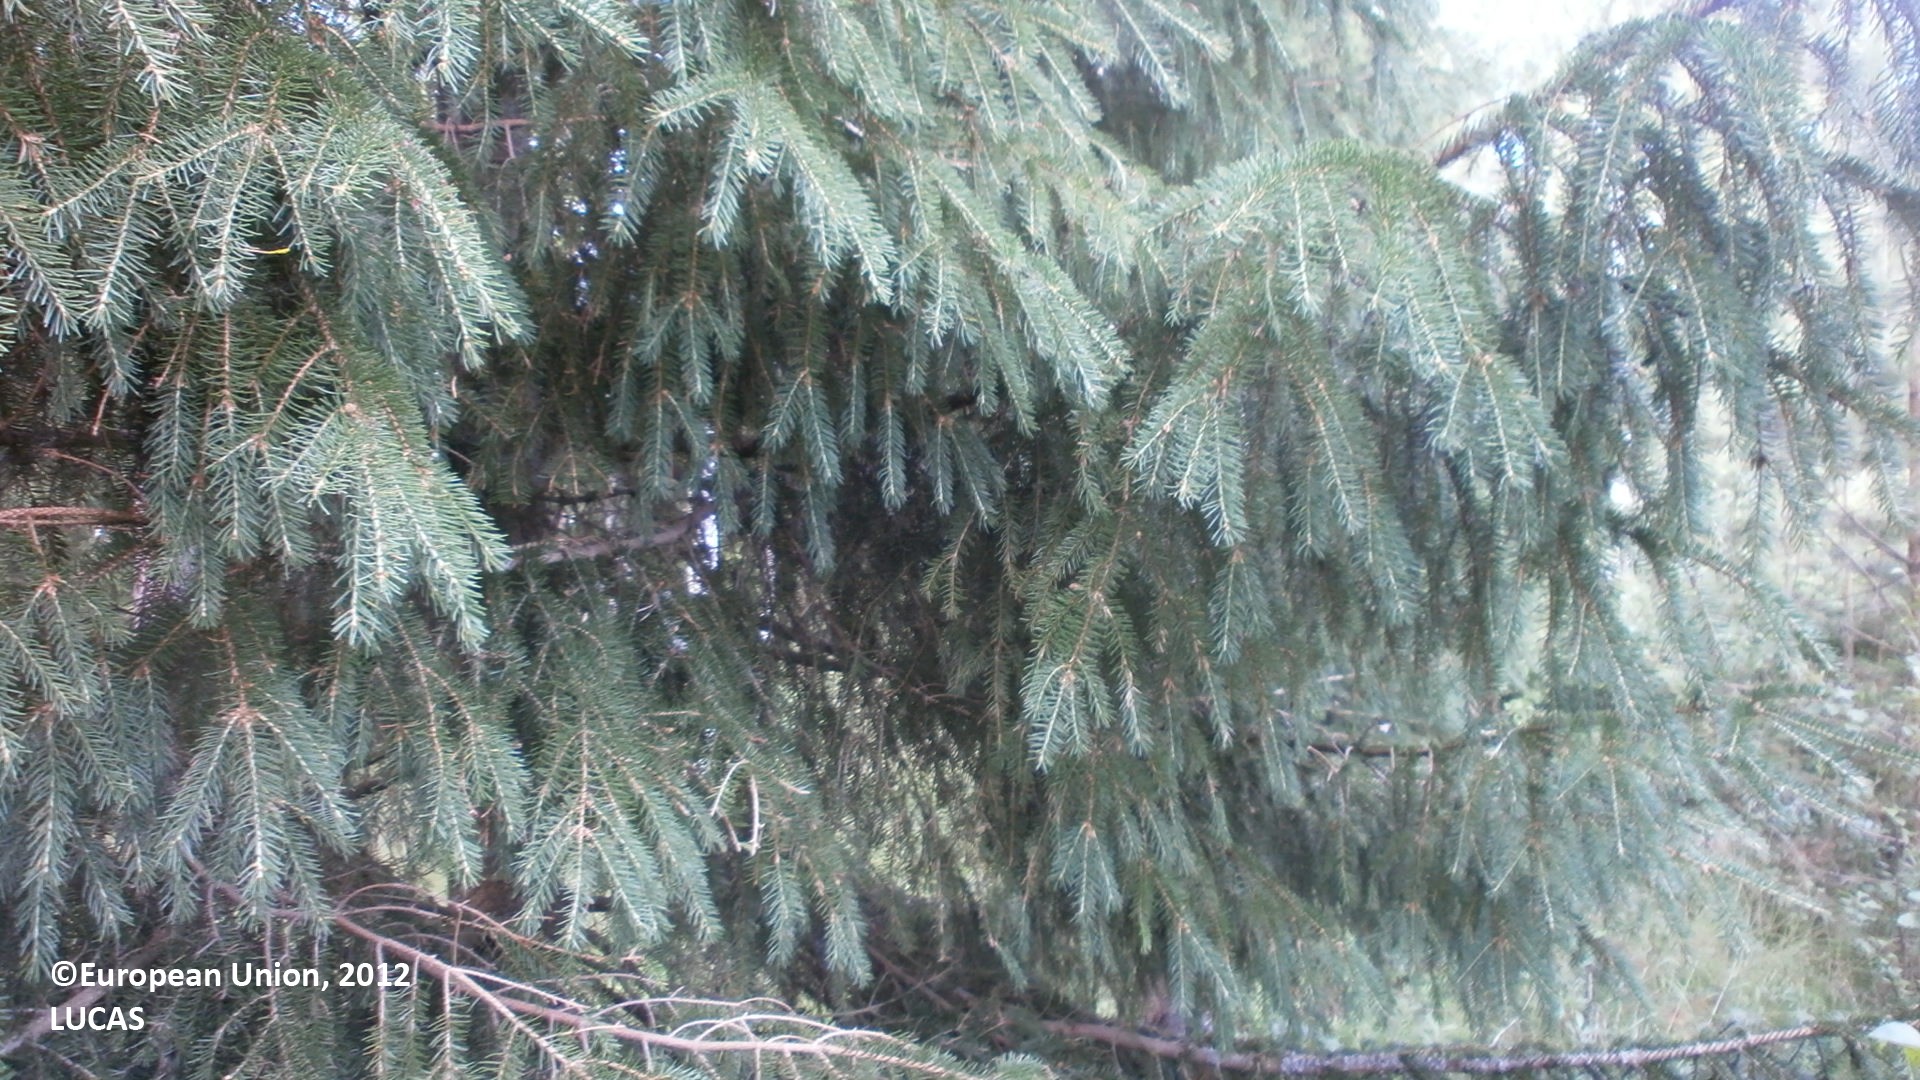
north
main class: Woodland
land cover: Spruce dominated mixed woodland
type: boreal forest
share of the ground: > 75 %
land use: Forestry
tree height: > 5 m
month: July
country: FI
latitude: 63.9780
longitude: 23.9779
